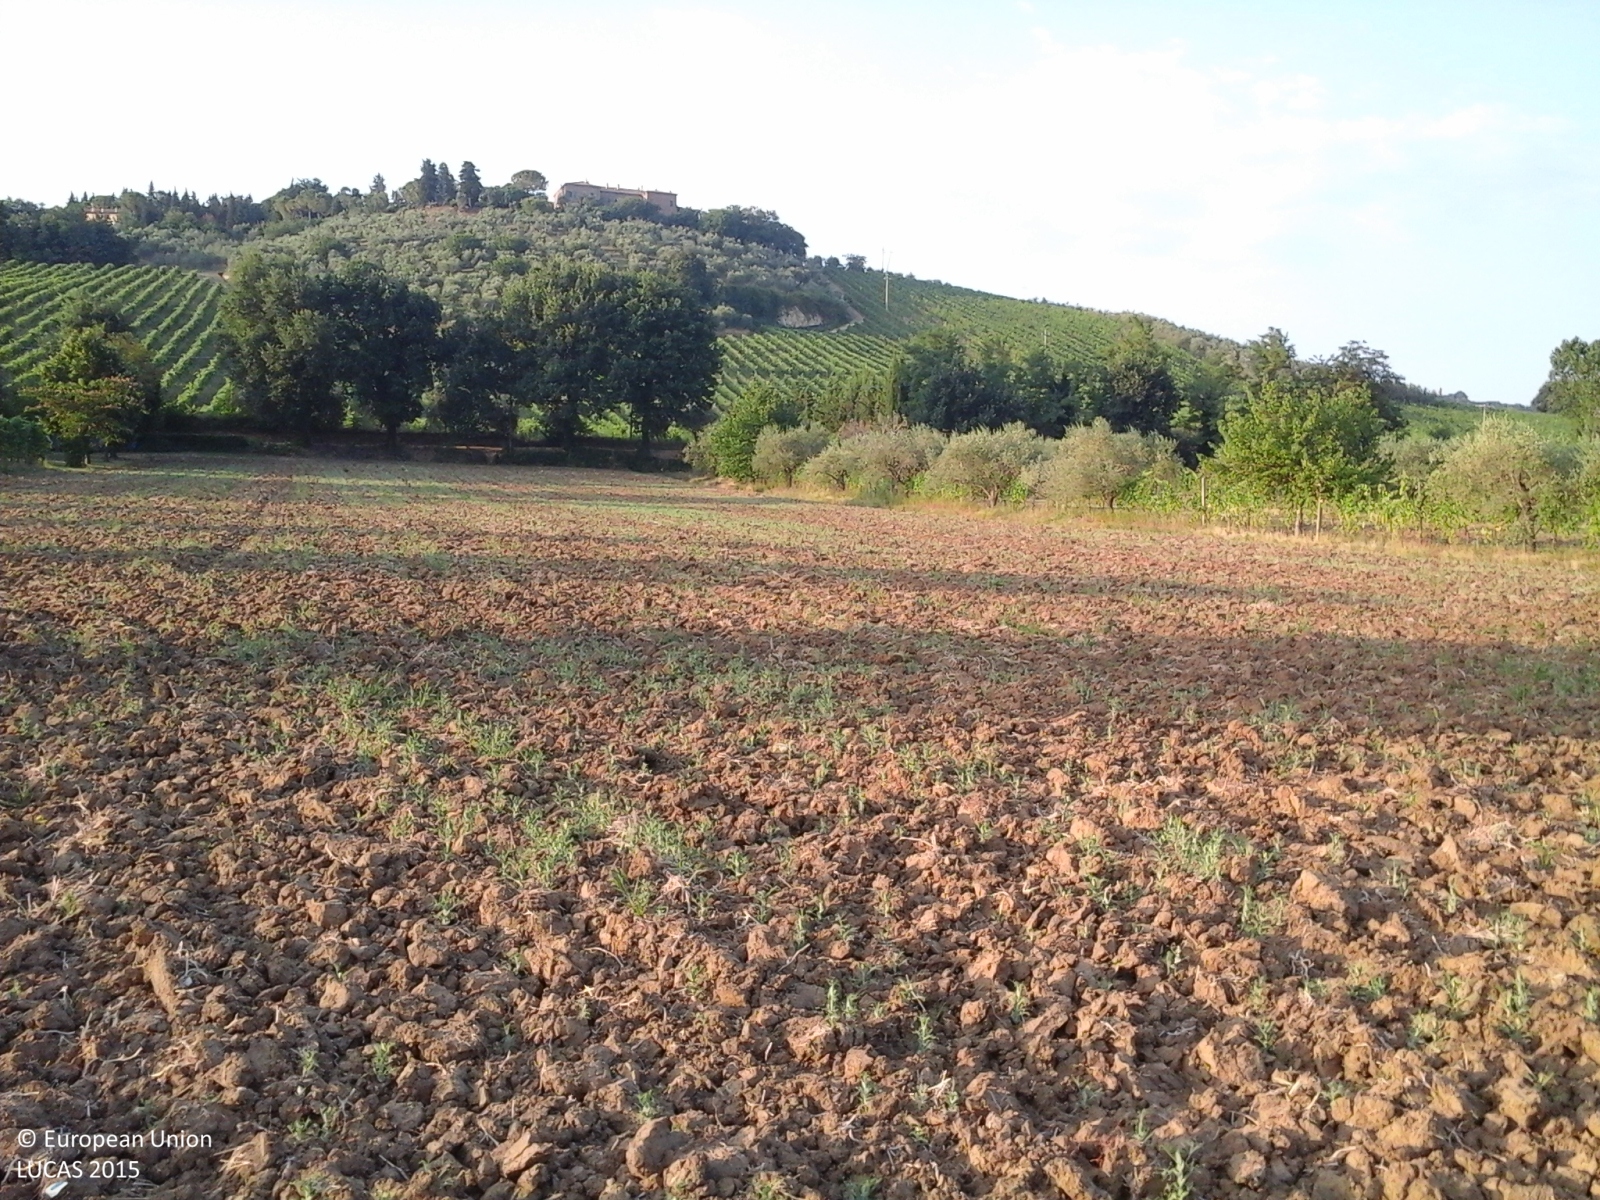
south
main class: Cropland
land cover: Other leguminous and mixtures for fodder
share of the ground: > 75 %
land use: Agriculture (excluding fallow land and kitchen gardens)
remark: Harvested field
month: July
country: IT
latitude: 44.0340
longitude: 12.4027
